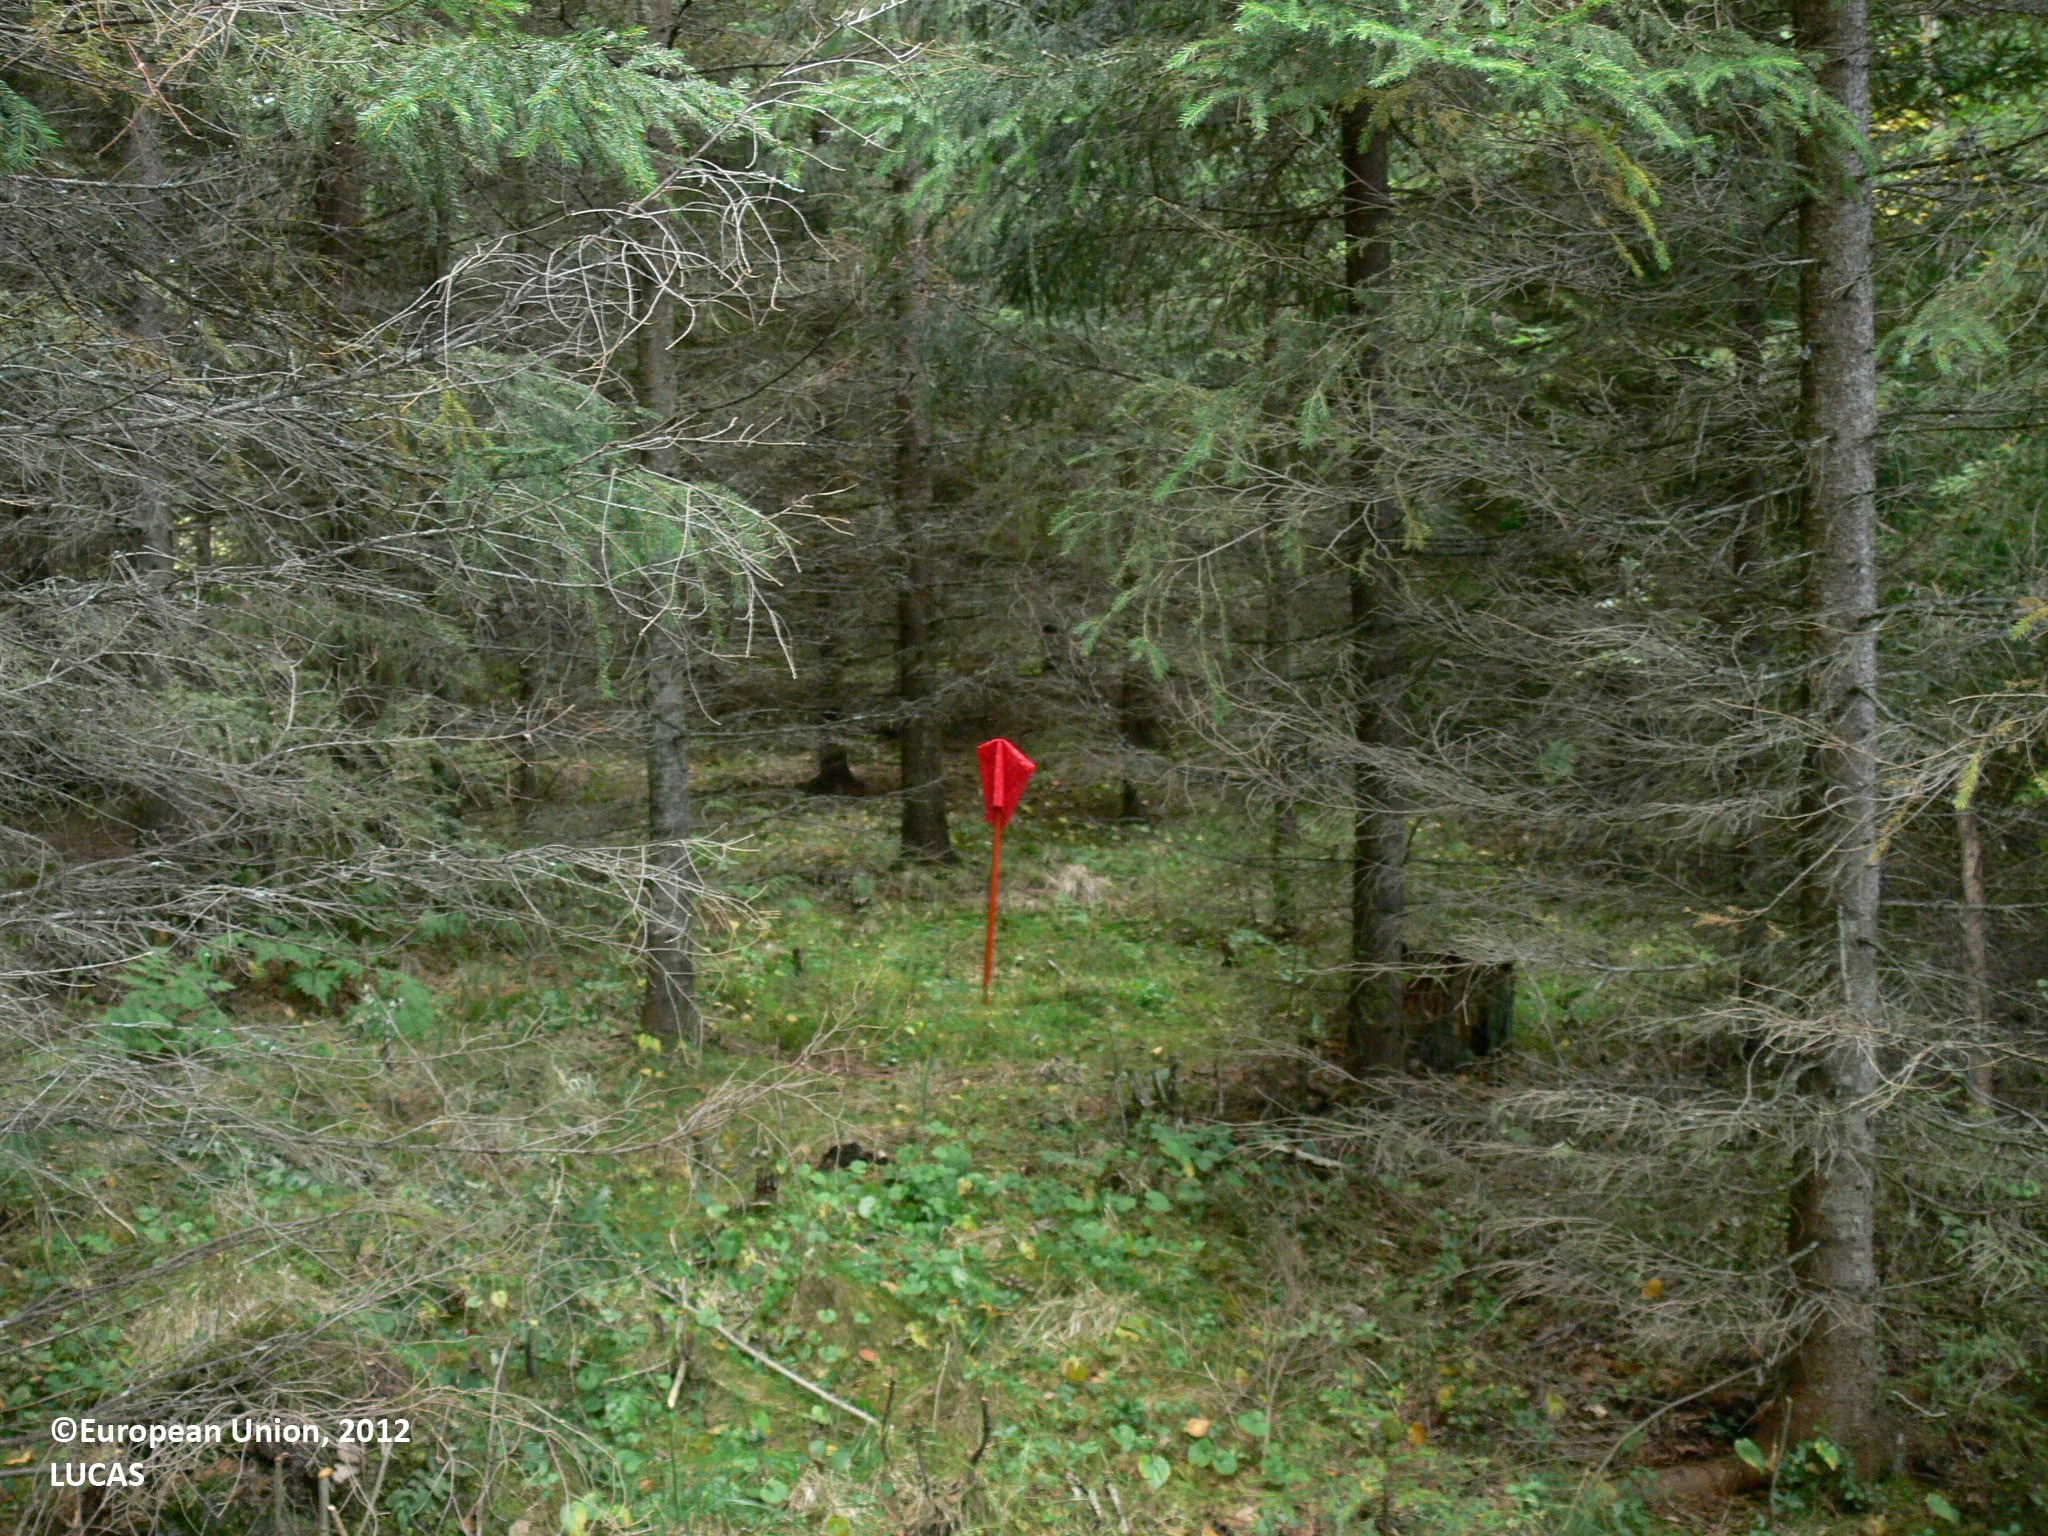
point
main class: Woodland
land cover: Spruce dominated coniferous woodland
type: boreal forest
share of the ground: > 75 %
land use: Forestry
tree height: > 5 m
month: August
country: FI
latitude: 61.9199
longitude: 30.1358
